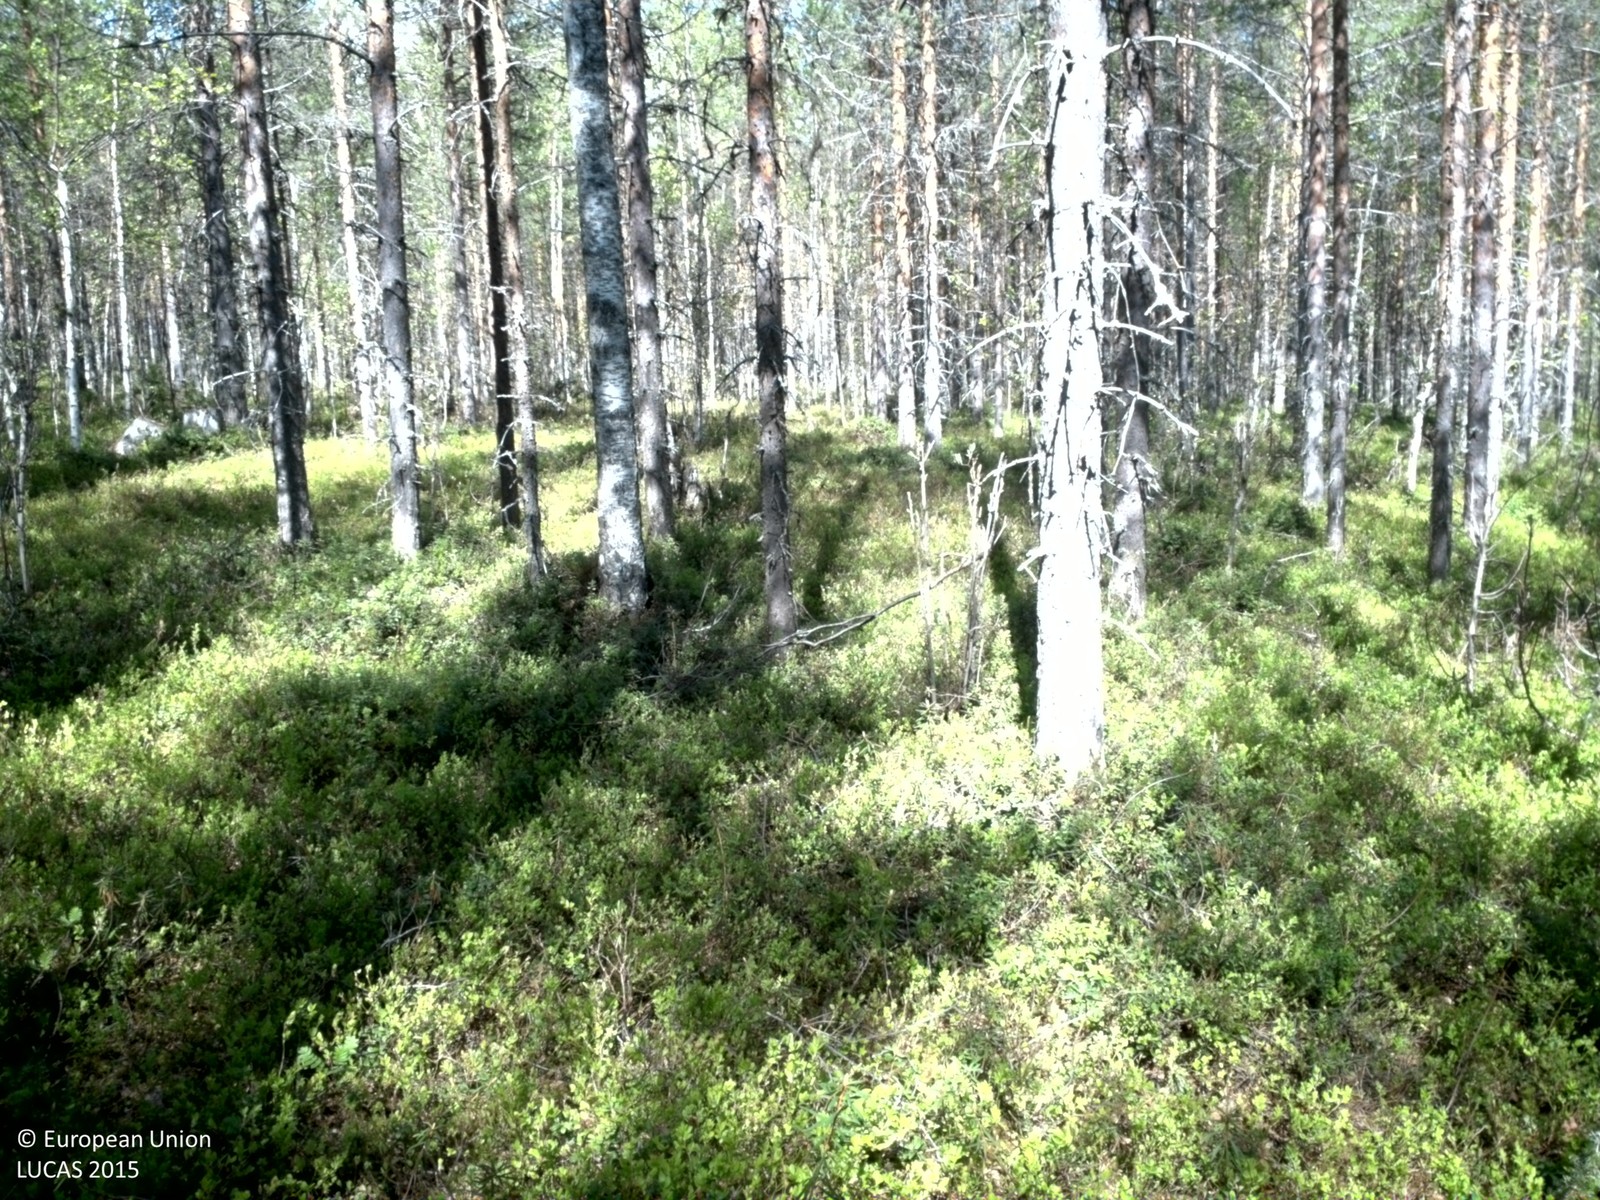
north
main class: Woodland
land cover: Pine dominated coniferous woodland
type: boreal forest
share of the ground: 50 - 75 %
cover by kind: coniferous forest trees 60 %, shrubs 30 %, broadleaved forest trees 10 %
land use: Forestry
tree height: > 5 m
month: June
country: SE
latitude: 66.5925
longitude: 22.3531
